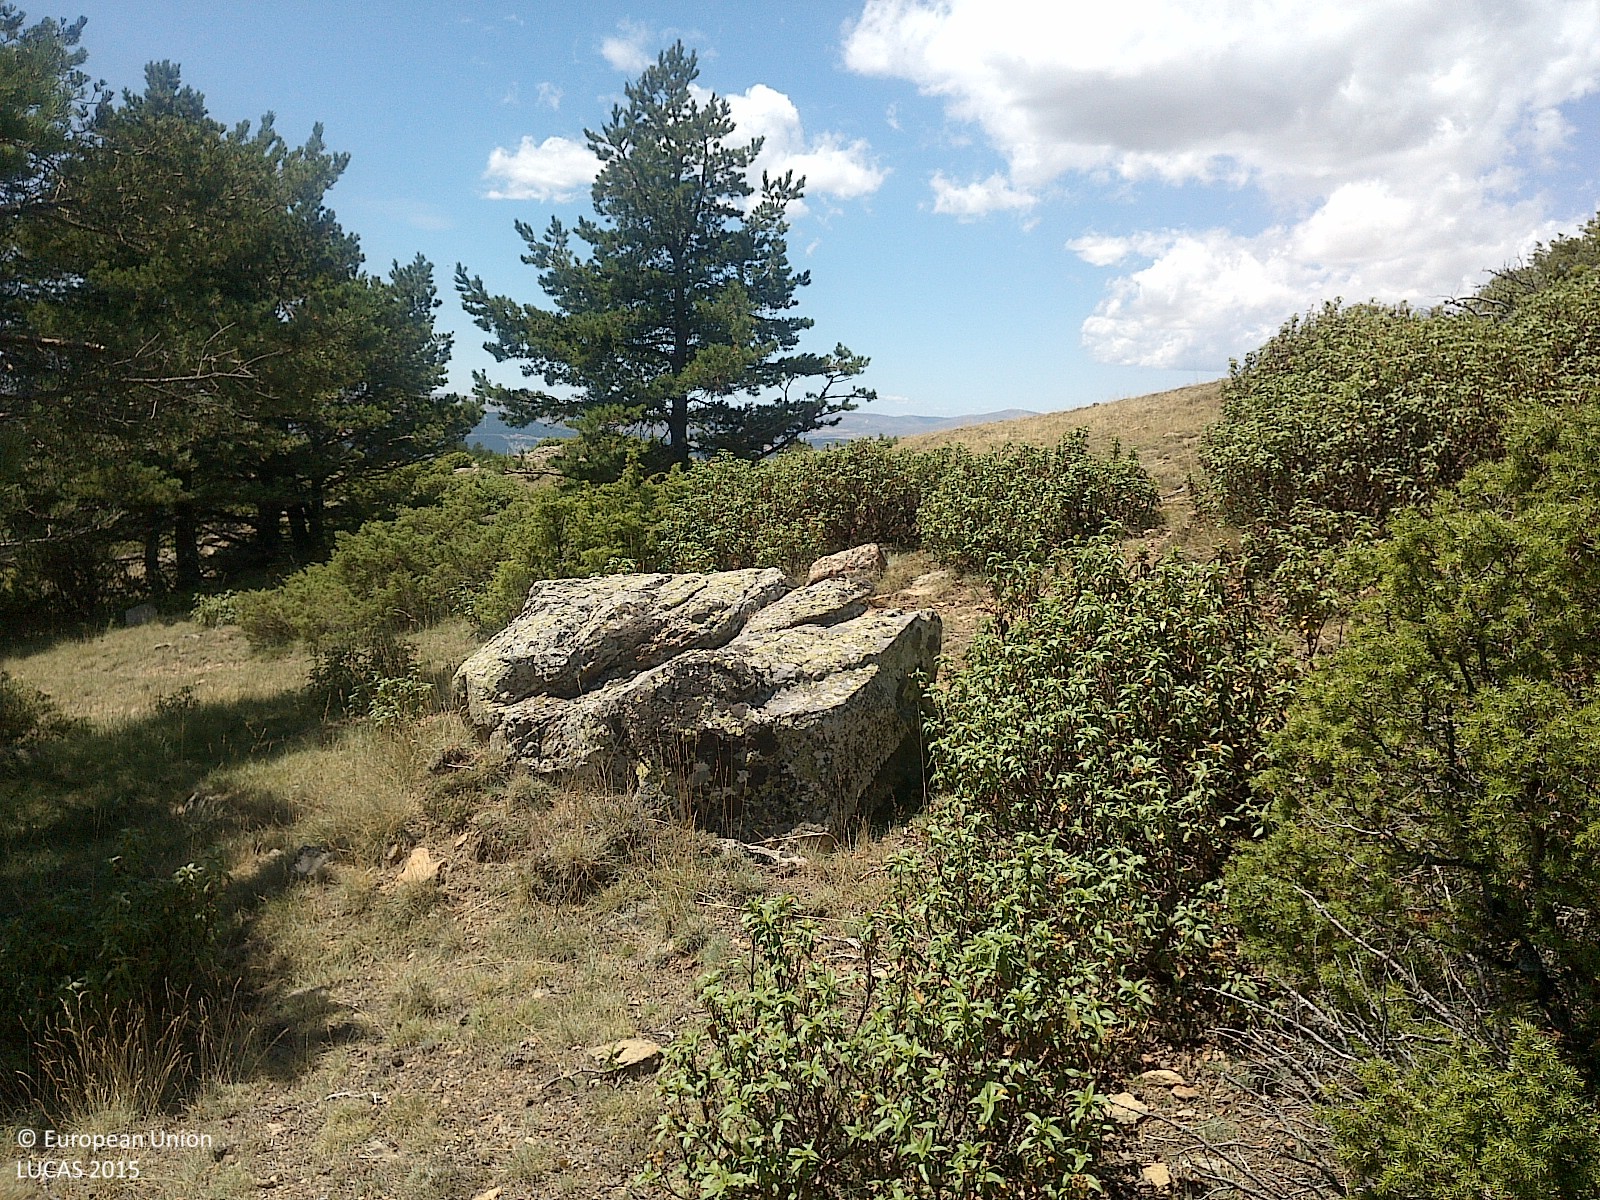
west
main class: Woodland
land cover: Pine dominated coniferous woodland
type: coniferous forest of the mediterranean region
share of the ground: 10 - 25 %
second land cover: Grassland without tree/shrub cover
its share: 25 - 50 %
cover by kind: herbaceous plants 40 %, shrubs 25 %, coniferous forest trees 20 %, unconsolidated bare surface 10 %, consolidated bare surface 5 %
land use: Forestry
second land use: Agriculture (excluding fallow land and kitchen gardens)
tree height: < 5 m
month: July
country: ES
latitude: 41.9962
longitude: -2.1206
